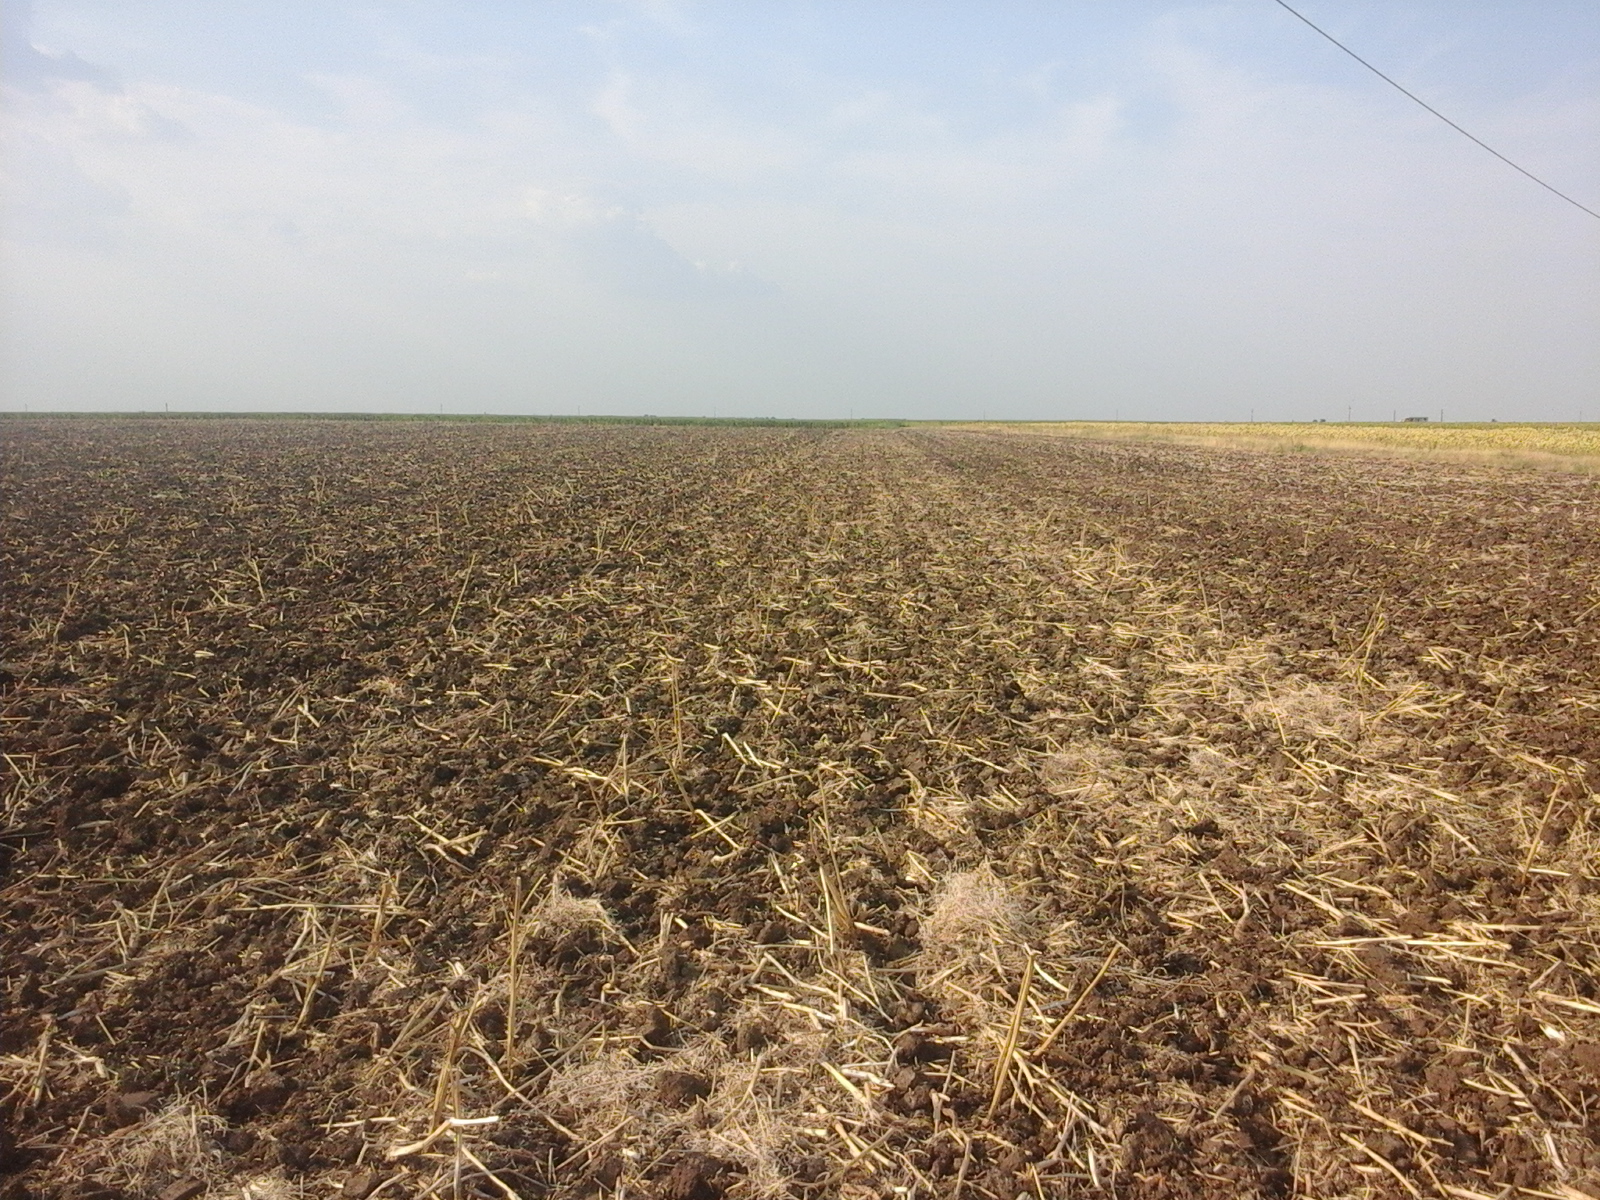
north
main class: Cropland
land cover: Rape and turnip rape
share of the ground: 25 - 50 %
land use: Agriculture (excluding fallow land and kitchen gardens)
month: August
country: RO
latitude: 44.1090
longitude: 23.4551
